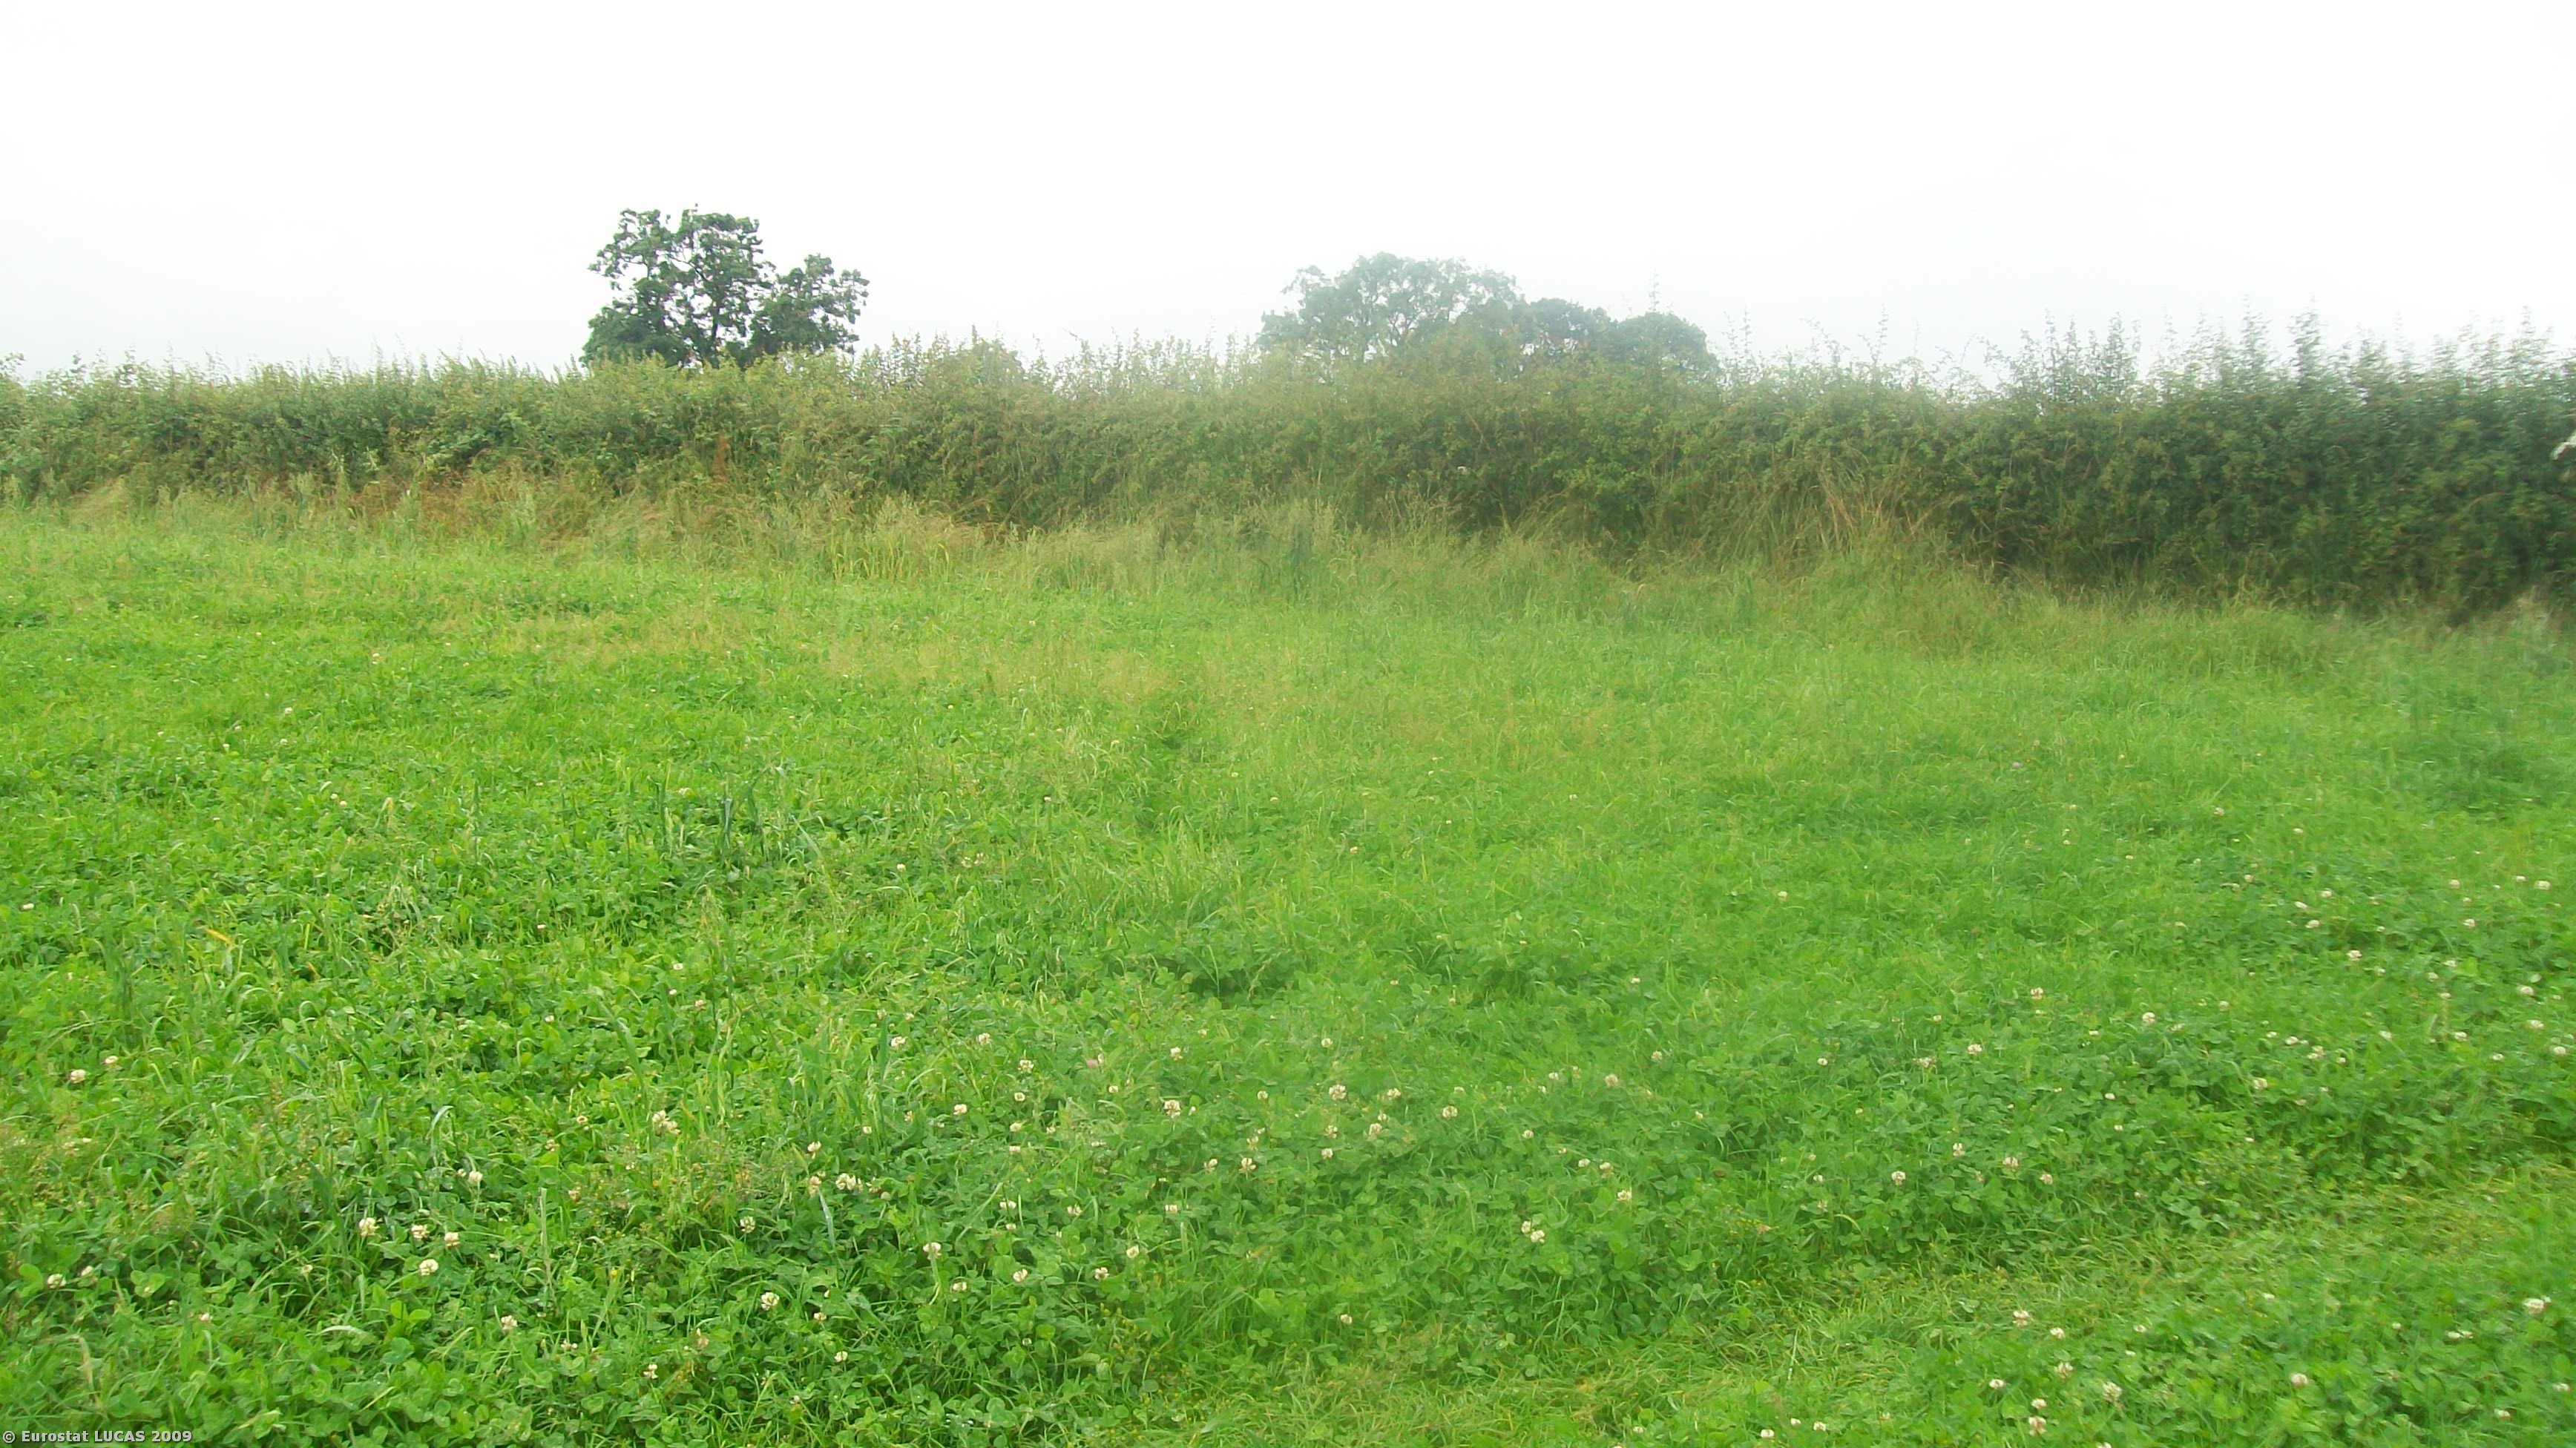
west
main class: Grassland
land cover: Grassland without tree/shrub cover
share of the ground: > 75 %
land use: Agriculture (excluding fallow land and kitchen gardens)
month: July
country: GB
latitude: 52.9333
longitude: -2.6703
